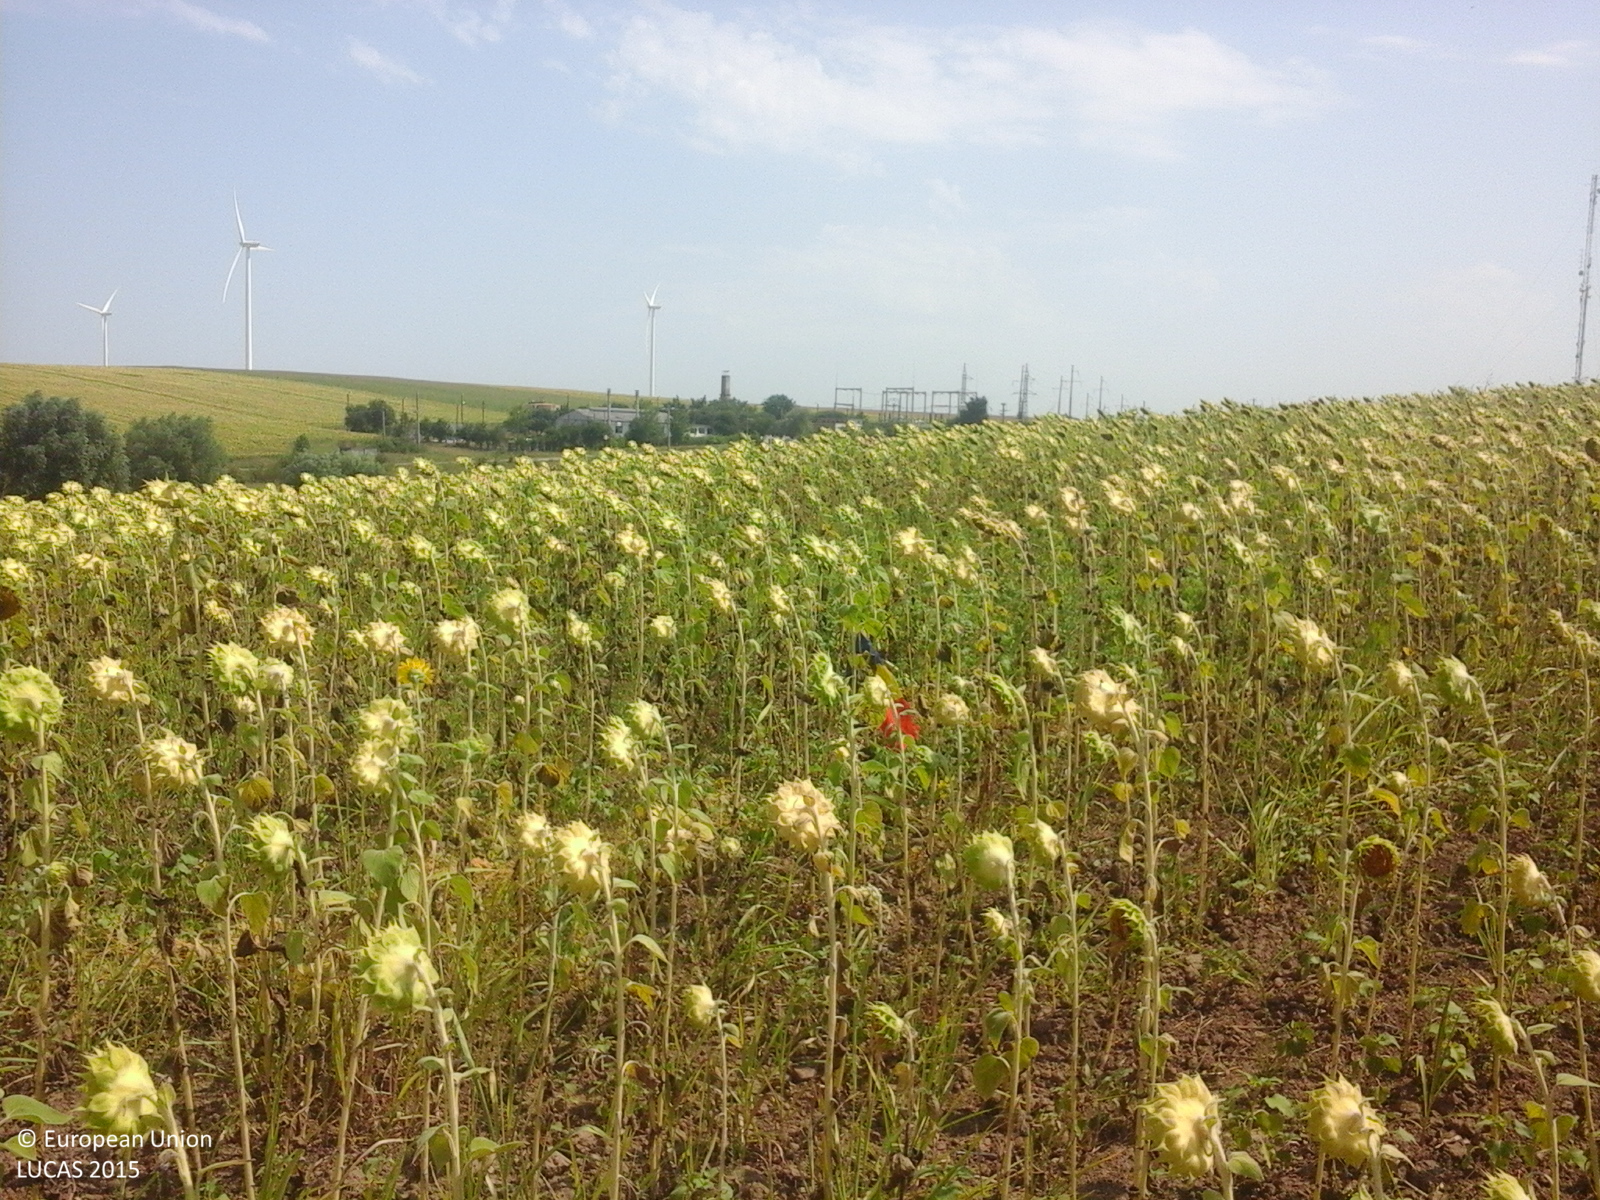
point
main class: Cropland
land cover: Sunflower
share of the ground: > 75 %
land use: Agriculture (excluding fallow land and kitchen gardens)
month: August
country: RO
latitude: 44.3153
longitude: 28.1775
